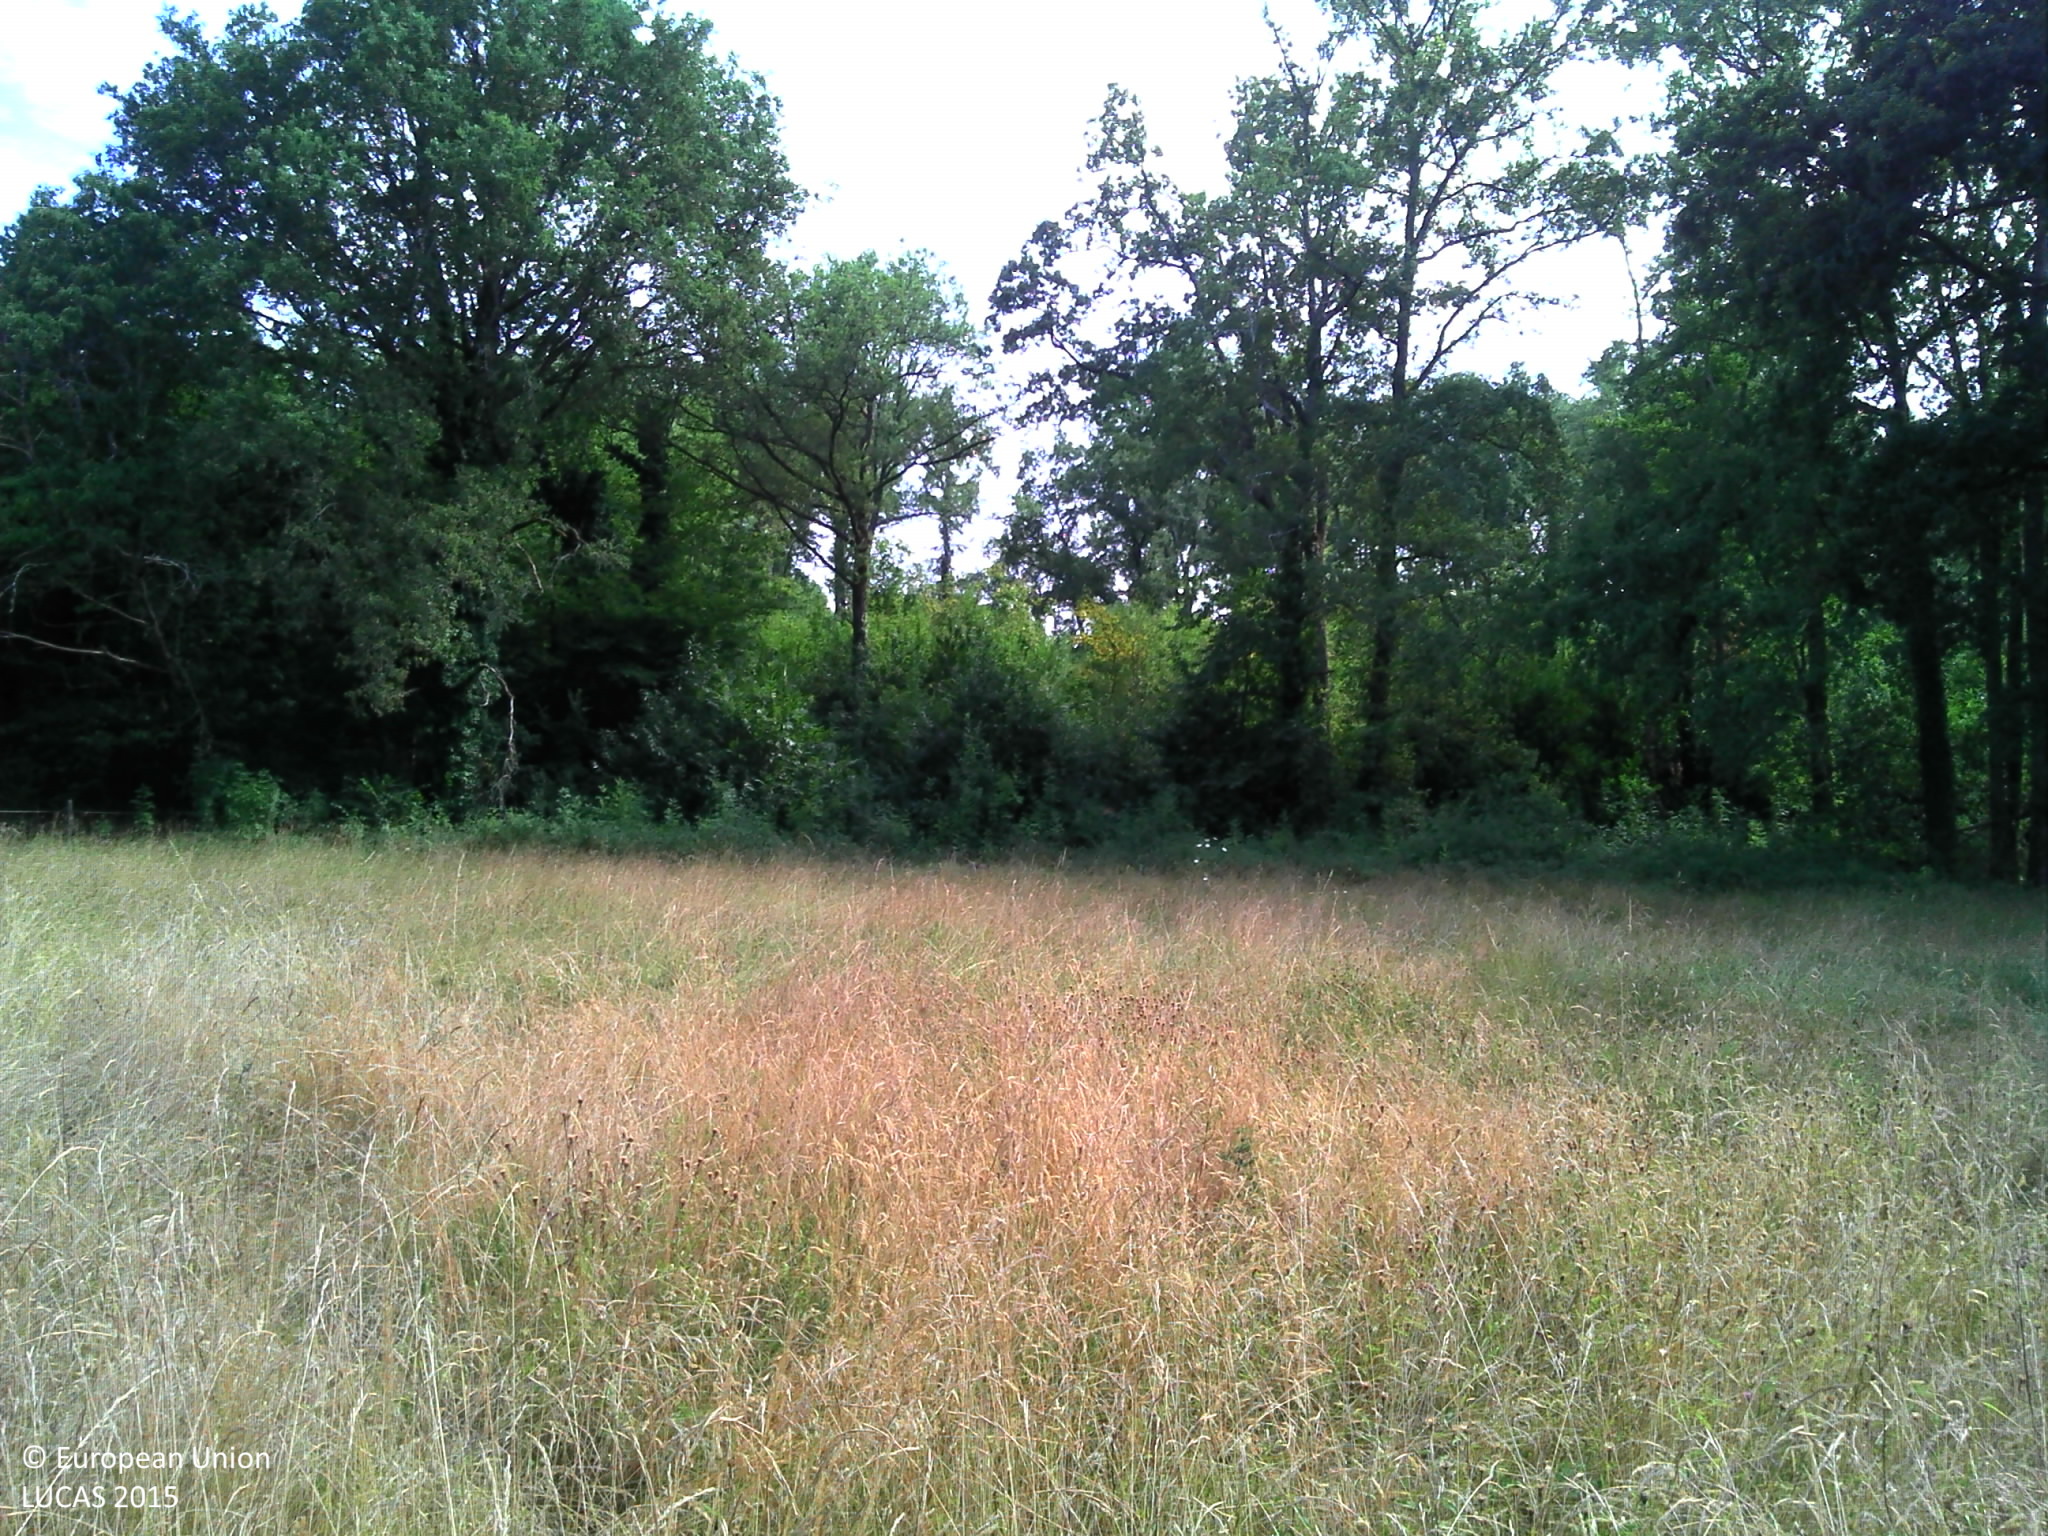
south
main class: Grassland
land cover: Grassland without tree/shrub cover
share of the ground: > 75 %
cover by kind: herbaceous plants 90 %, shrubs 5 %, unconsolidated bare surface 5 %
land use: Agriculture (excluding fallow land and kitchen gardens)
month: July
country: FR
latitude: 45.0619
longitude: 0.5538
